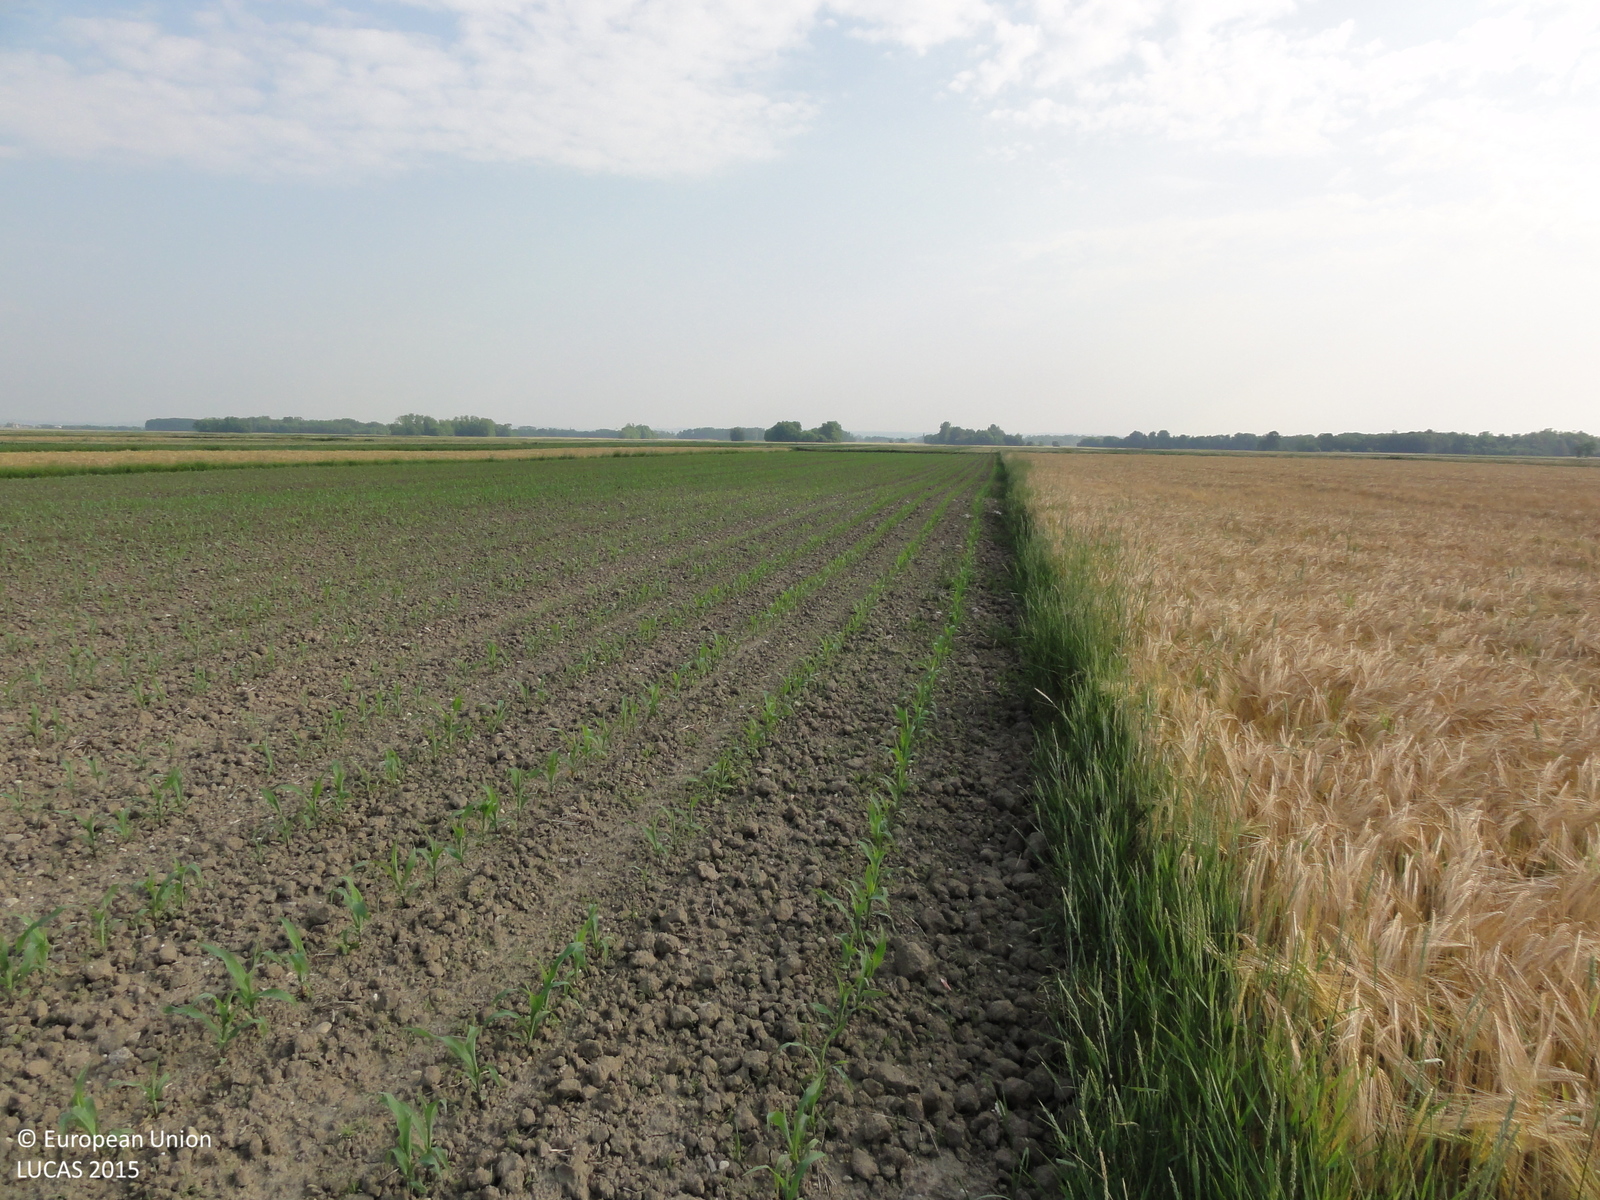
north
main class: Cropland
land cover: Barley
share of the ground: > 75 %
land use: Agriculture (excluding fallow land and kitchen gardens)
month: June
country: SI
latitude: 46.6062
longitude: 16.1758
